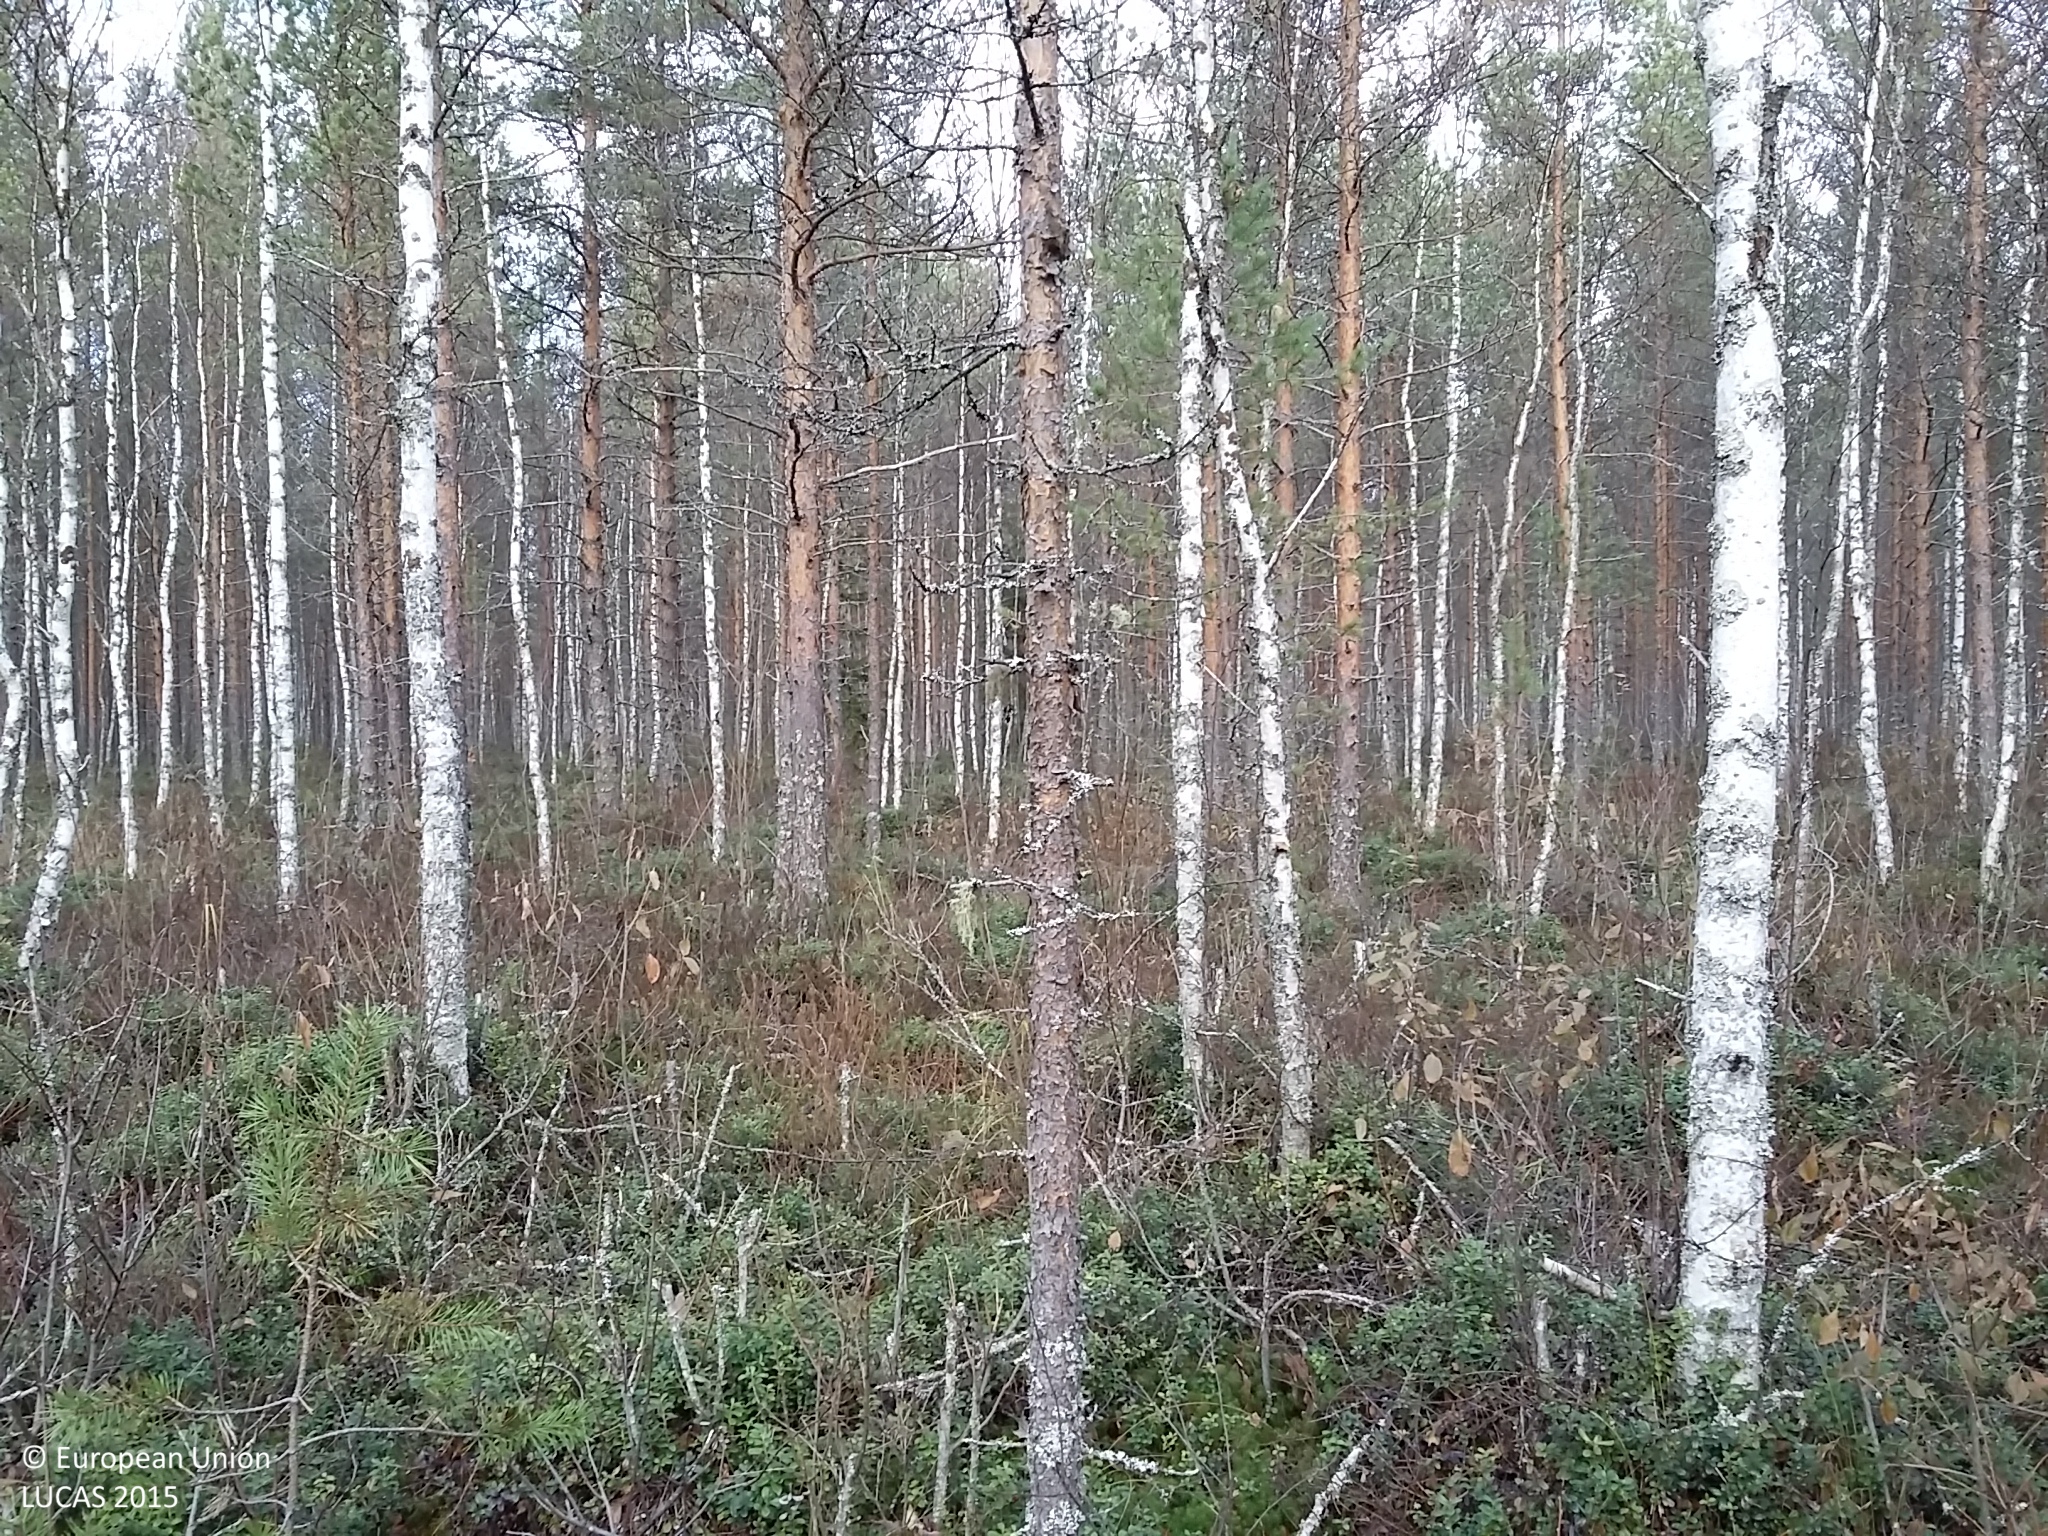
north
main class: Woodland
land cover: Pine dominated mixed woodland
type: boreal forest
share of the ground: > 75 %
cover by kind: coniferous forest trees 55 %, broadleaved forest trees 25 %, shrubs 10 %, herbaceous plants 5 %, lichens and mosses 5 %
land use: Forestry
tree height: > 5 m
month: October
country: FI
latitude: 64.6198
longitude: 25.5848
